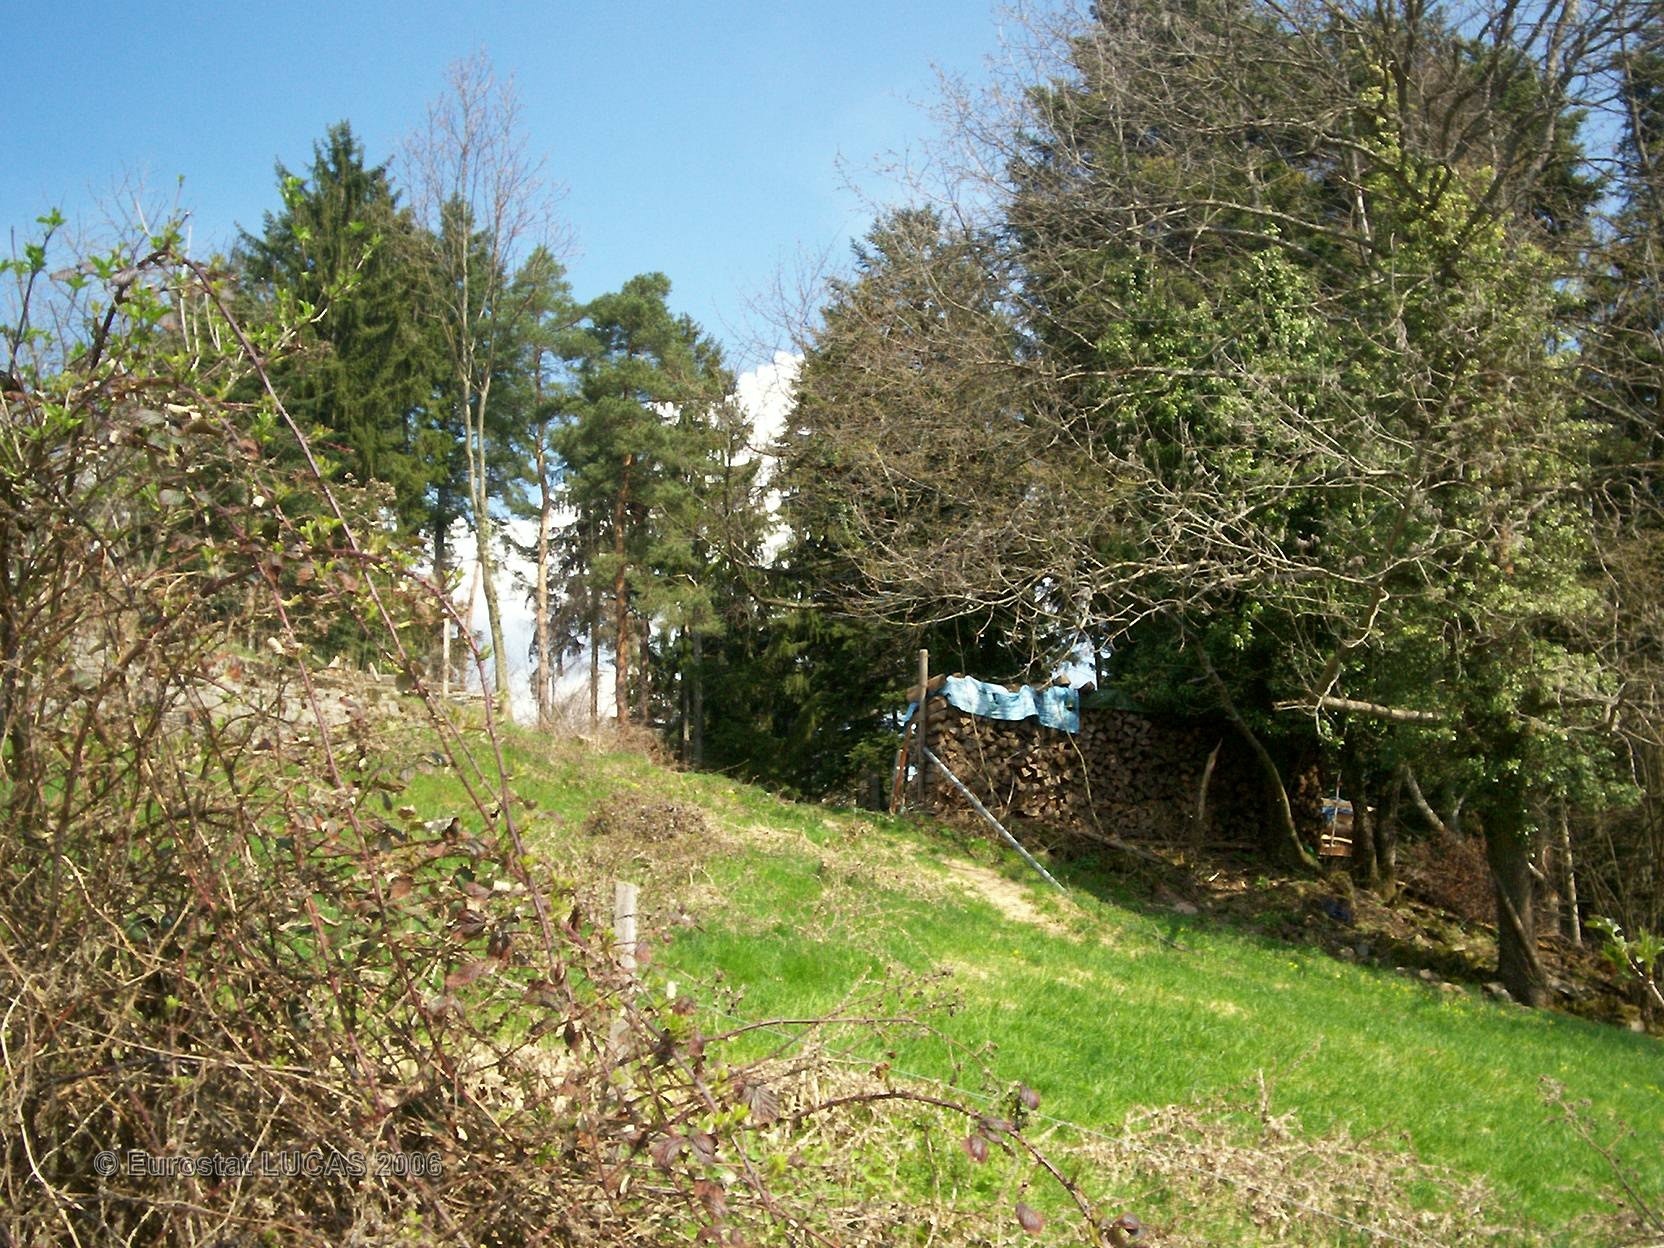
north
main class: Cropland
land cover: Other fruit trees and berries
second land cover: Grassland with sparse tree/shrub cover
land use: Kitchen garden
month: April
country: FR
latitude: 48.0238
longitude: 7.1183
